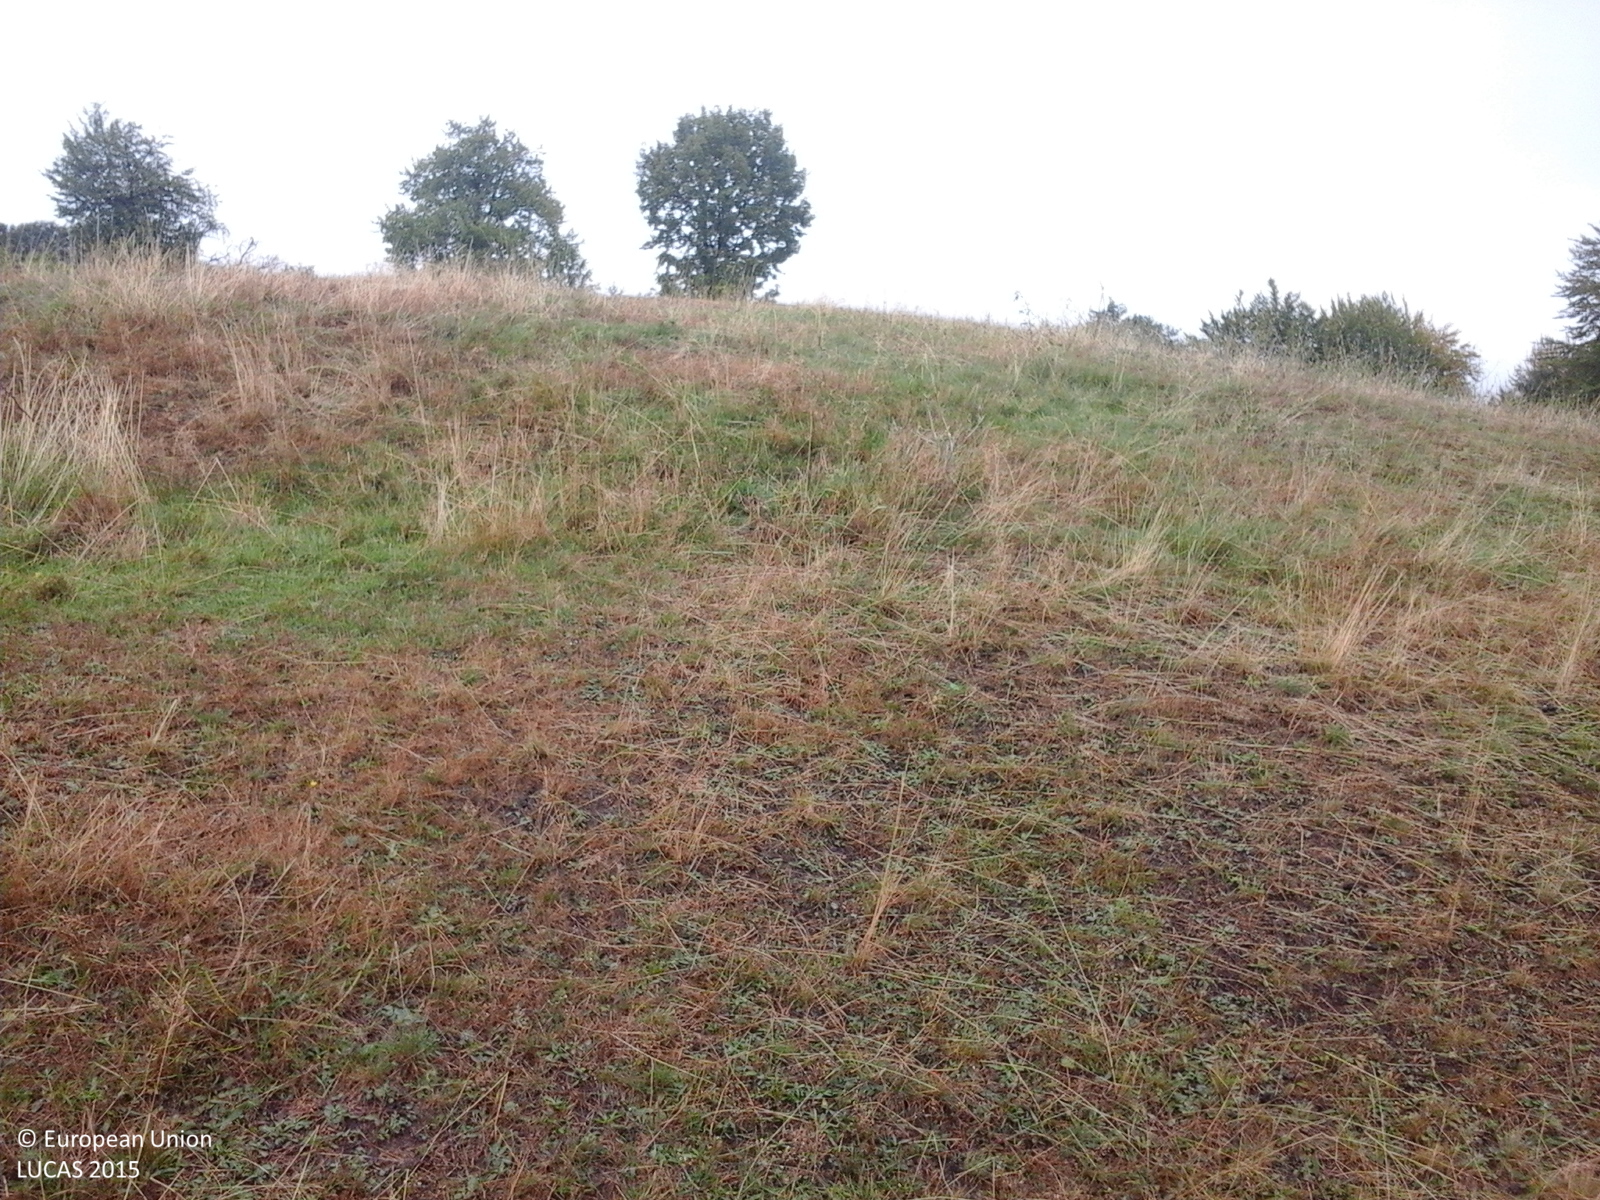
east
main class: Grassland
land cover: Grassland without tree/shrub cover
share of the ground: > 75 %
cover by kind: herbaceous plants 100 %
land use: Agriculture (excluding fallow land and kitchen gardens)
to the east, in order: Grassland without tree/shrub cover; Ditches and canals; Tracks; Grassland without tree/shrub cover; Grassland with sparse tree/shrub cover; Grassland without tree/shrub cover; Electric lines; Grassland without tree/shrub cover; Grassland with sparse tree/shrub cover; Fences; Other fruit trees and berries
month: September
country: RO
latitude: 45.2452
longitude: 24.5125
